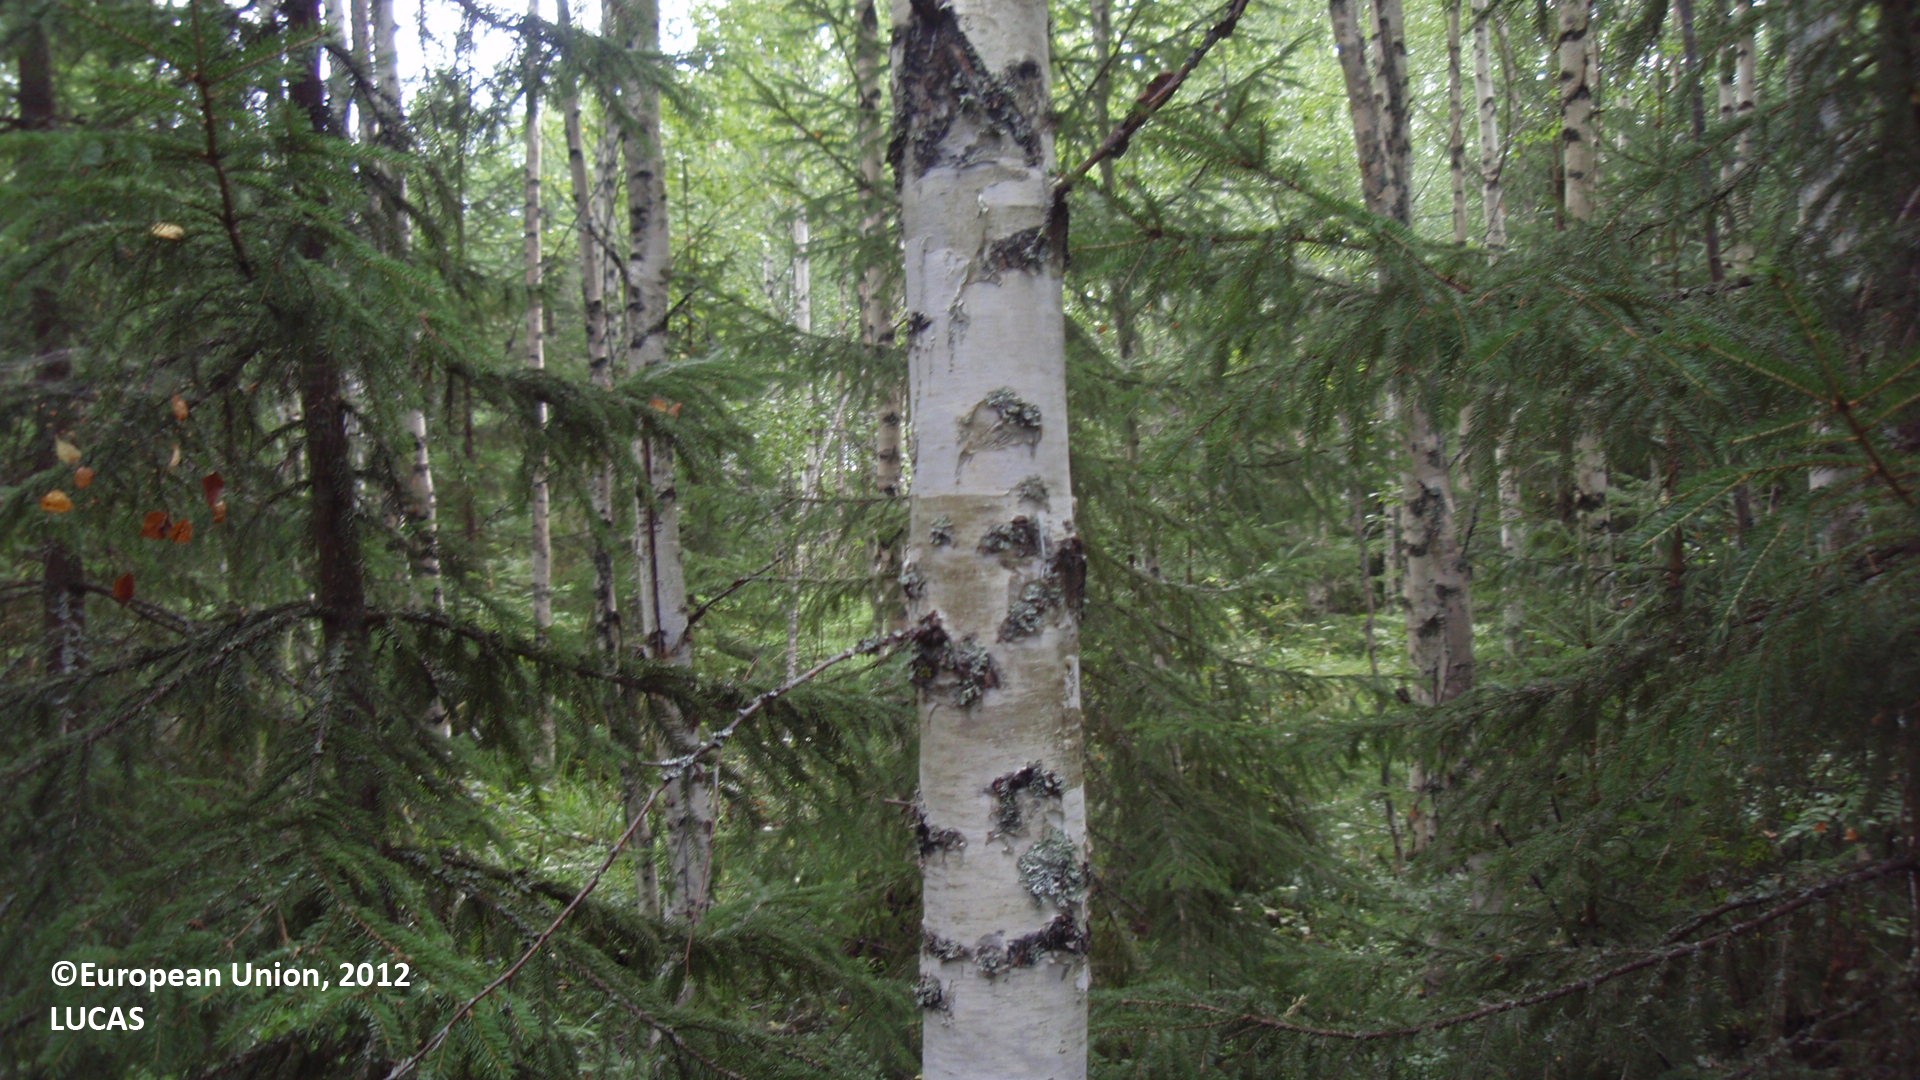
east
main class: Woodland
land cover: Spruce dominated mixed woodland
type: boreal forest
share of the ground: 50 - 75 %
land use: Forestry
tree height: > 5 m
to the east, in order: Spruce dominated mixed woodland; Ditches and canals; Tracks; Broadleaved woodland; Pine dominated mixed woodland; Grassland with sparse tree/shrub cover; Spruce dominated mixed woodland; Ditches and canals; Spruce dominated mixed woodland
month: August
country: FI
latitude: 60.9290
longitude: 27.3167
